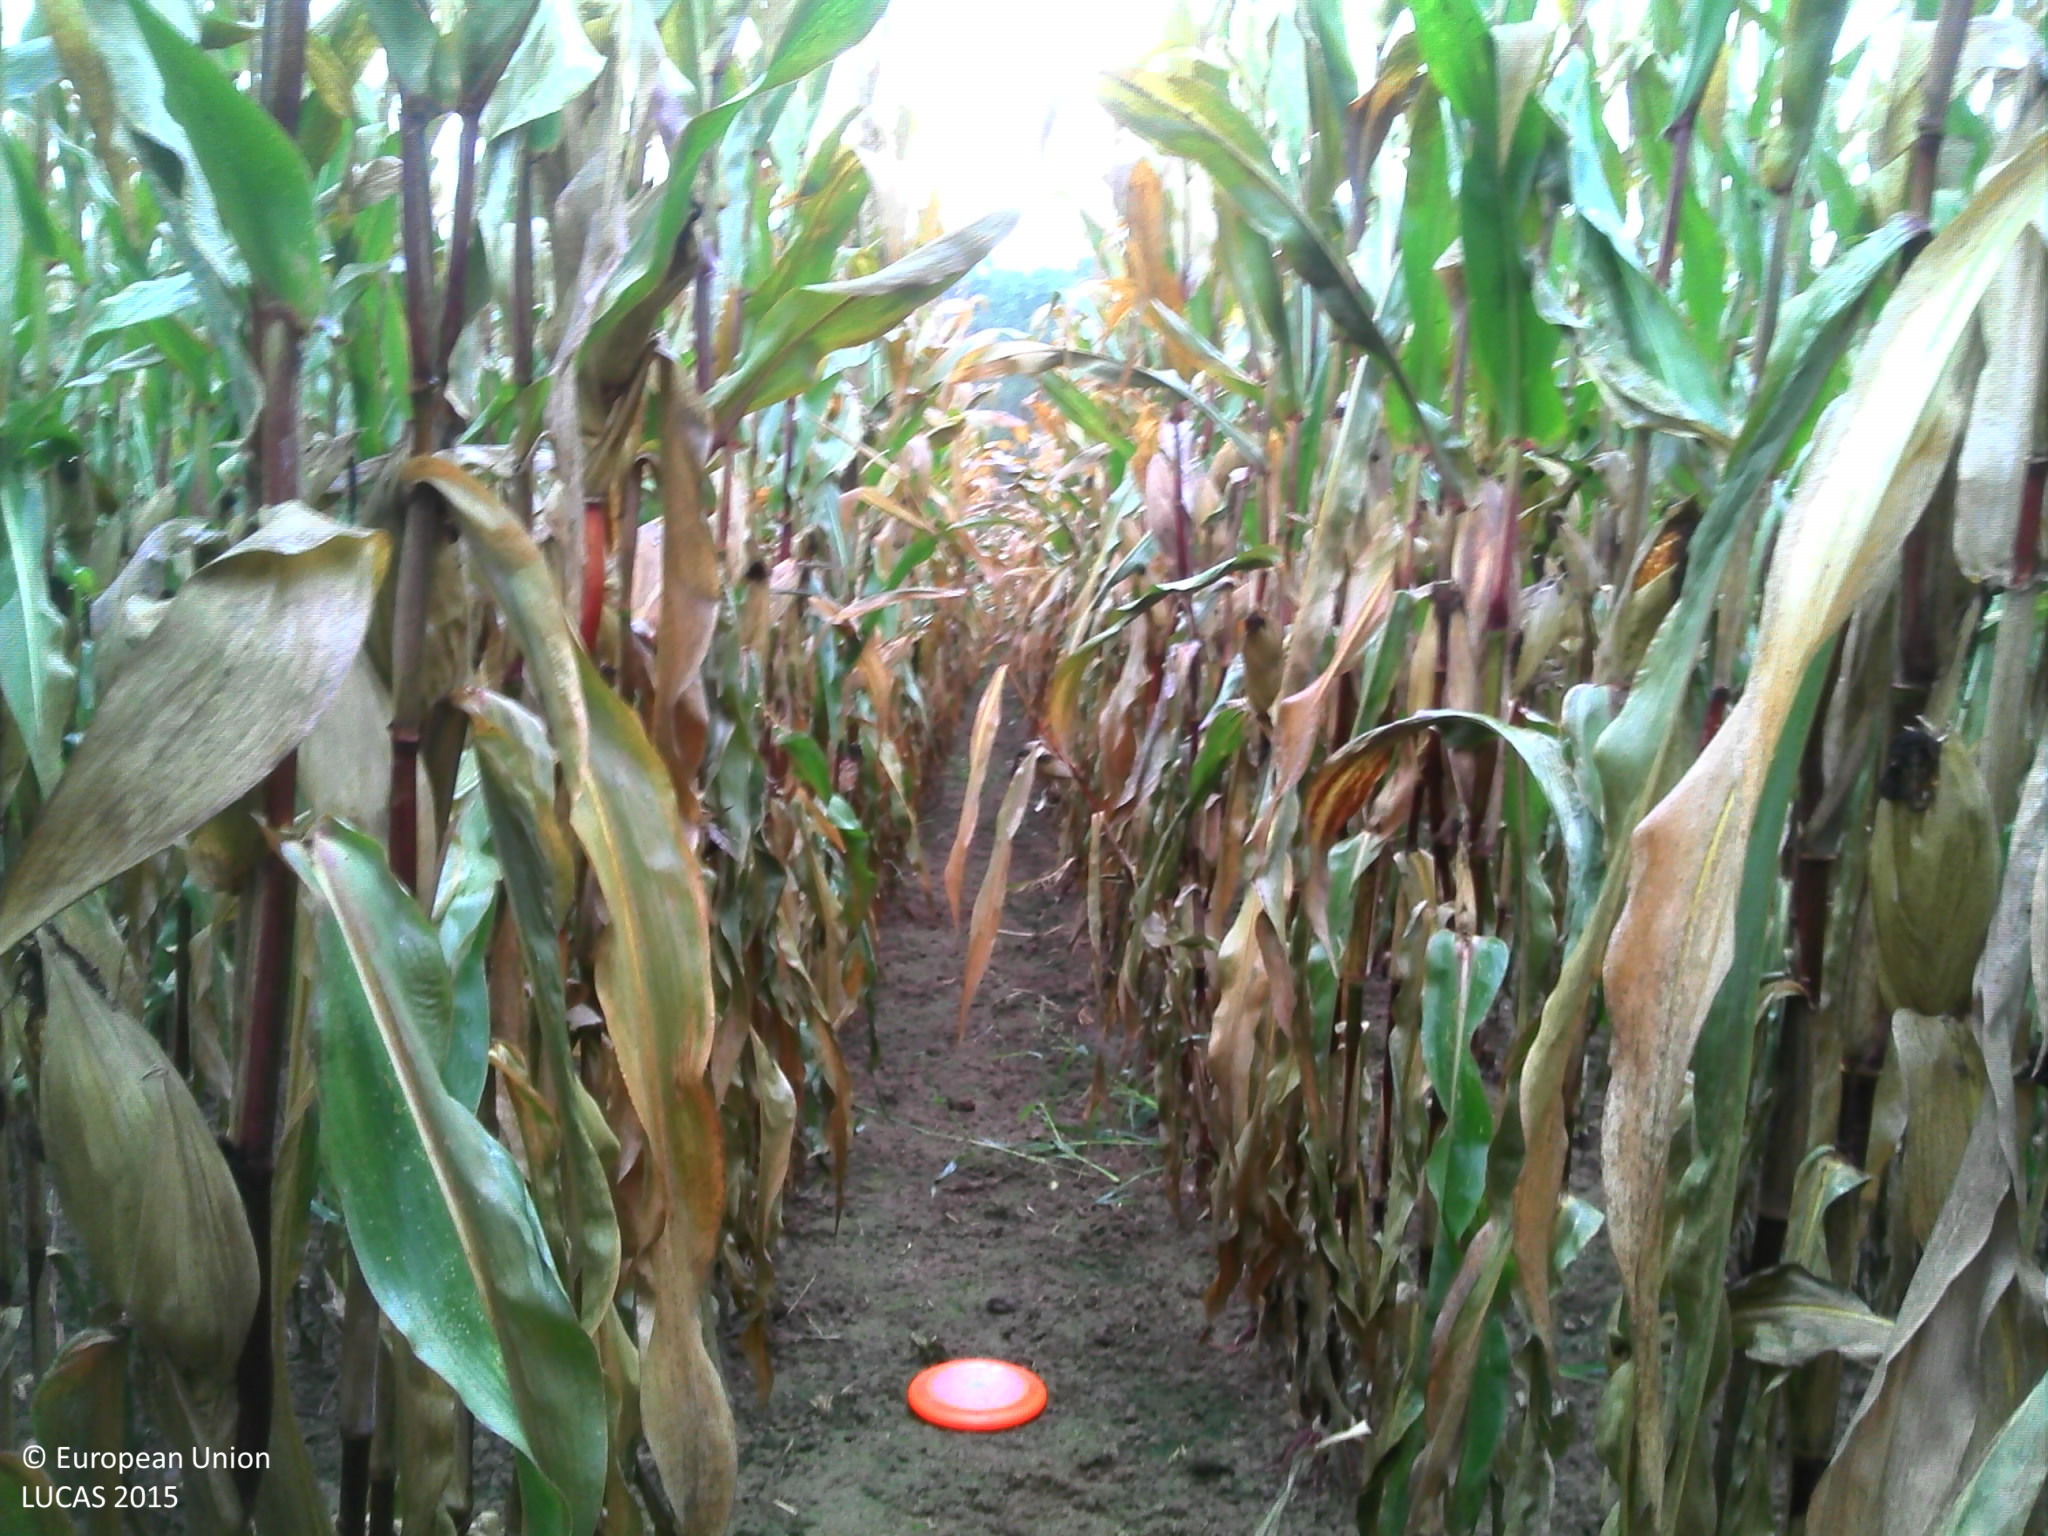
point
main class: Cropland
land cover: Maize
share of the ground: > 75 %
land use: Agriculture (excluding fallow land and kitchen gardens)
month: October
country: BE
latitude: 50.7706
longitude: 4.8495
